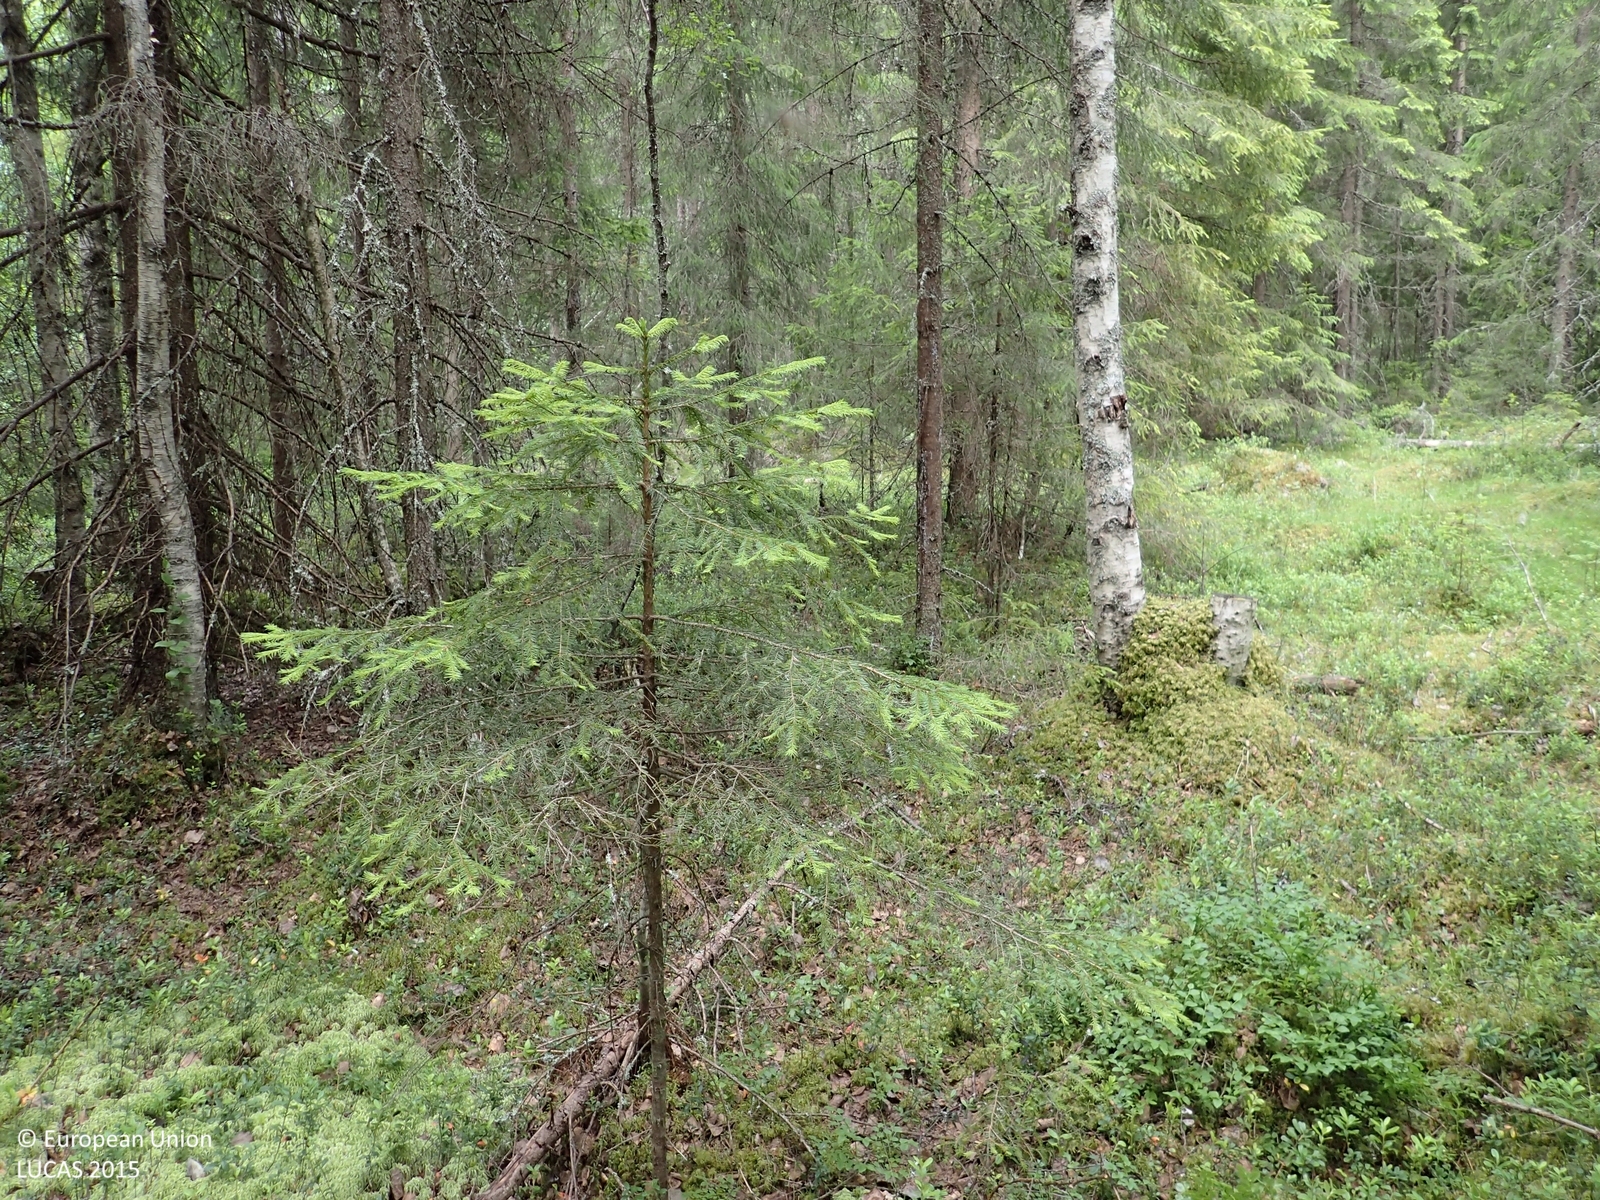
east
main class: Woodland
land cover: Spruce dominated coniferous woodland
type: boreal forest
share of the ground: > 75 %
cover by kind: coniferous forest trees 80 %, shrubs 10 %, broadleaved forest trees 5 %, lichens and mosses 5 %
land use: Forestry
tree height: > 5 m
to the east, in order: Spruce dominated coniferous woodland; Ditches and canals; Spruce dominated coniferous woodland; Ditches and canals; Spruce dominated coniferous woodland; Ditches and canals; Spruce dominated coniferous woodland; Ditches and canals; Spruce dominated coniferous woodland; Ditches and canals; Spruce dominated coniferous woodland
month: July
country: FI
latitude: 62.7518
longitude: 21.7715
